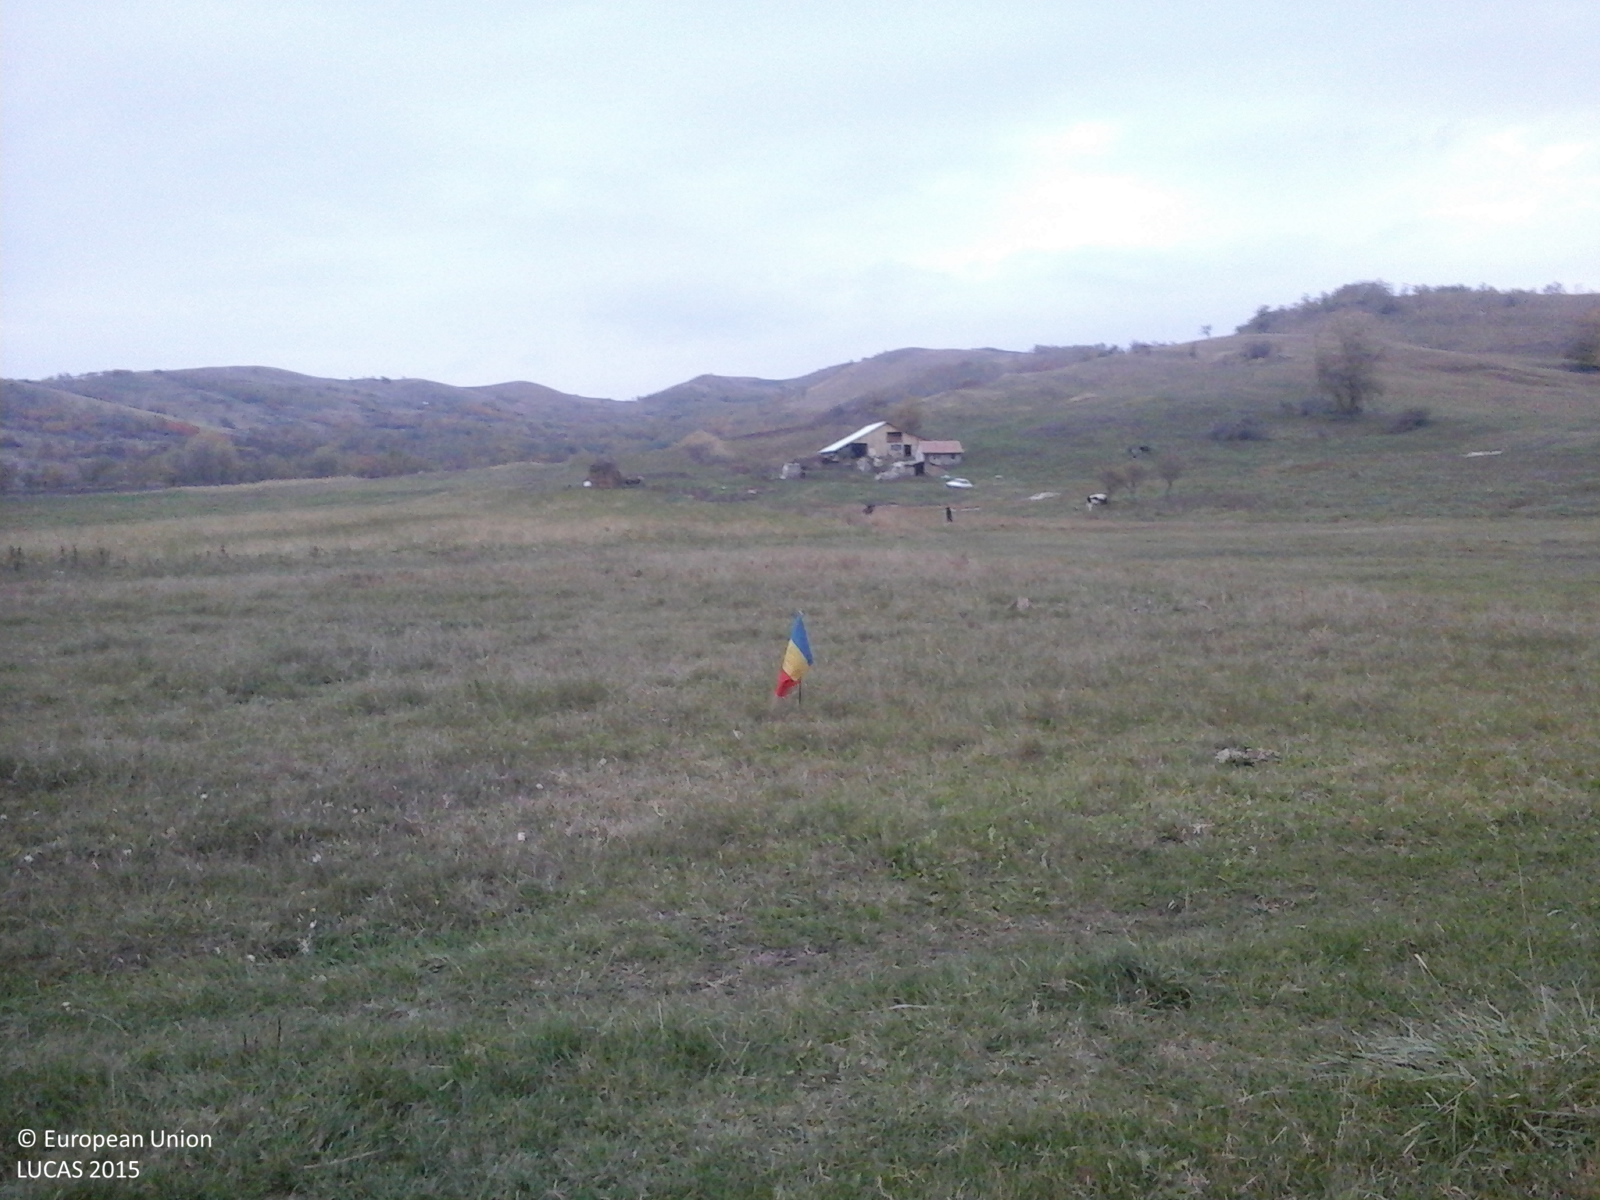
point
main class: Grassland
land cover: Grassland without tree/shrub cover
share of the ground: > 75 %
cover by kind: herbaceous plants 100 %
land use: Agriculture (excluding fallow land and kitchen gardens)
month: October
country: RO
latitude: 45.3958
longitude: 26.8028
